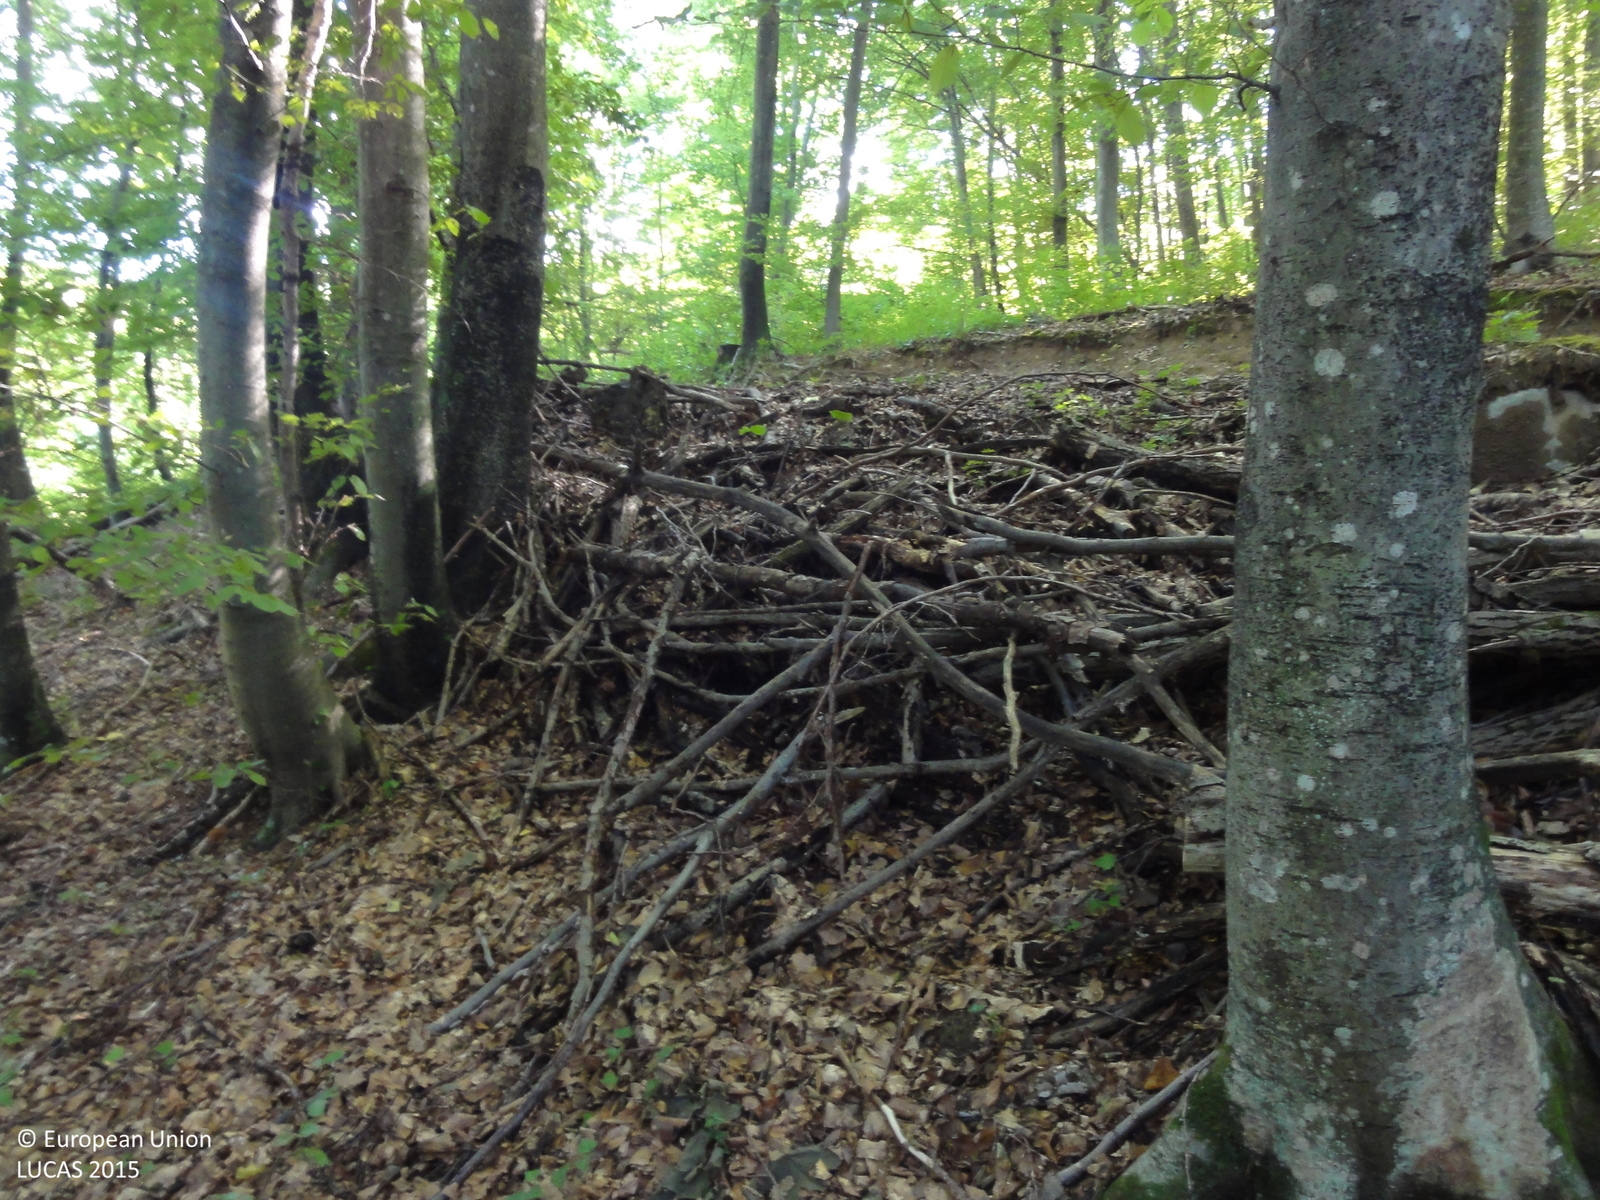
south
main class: Woodland
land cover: Broadleaved woodland
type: beech forest
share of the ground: > 75 %
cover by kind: broadleaved forest trees 100 %
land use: Forestry
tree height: > 5 m
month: September
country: SI
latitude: 45.8143
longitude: 15.4665
